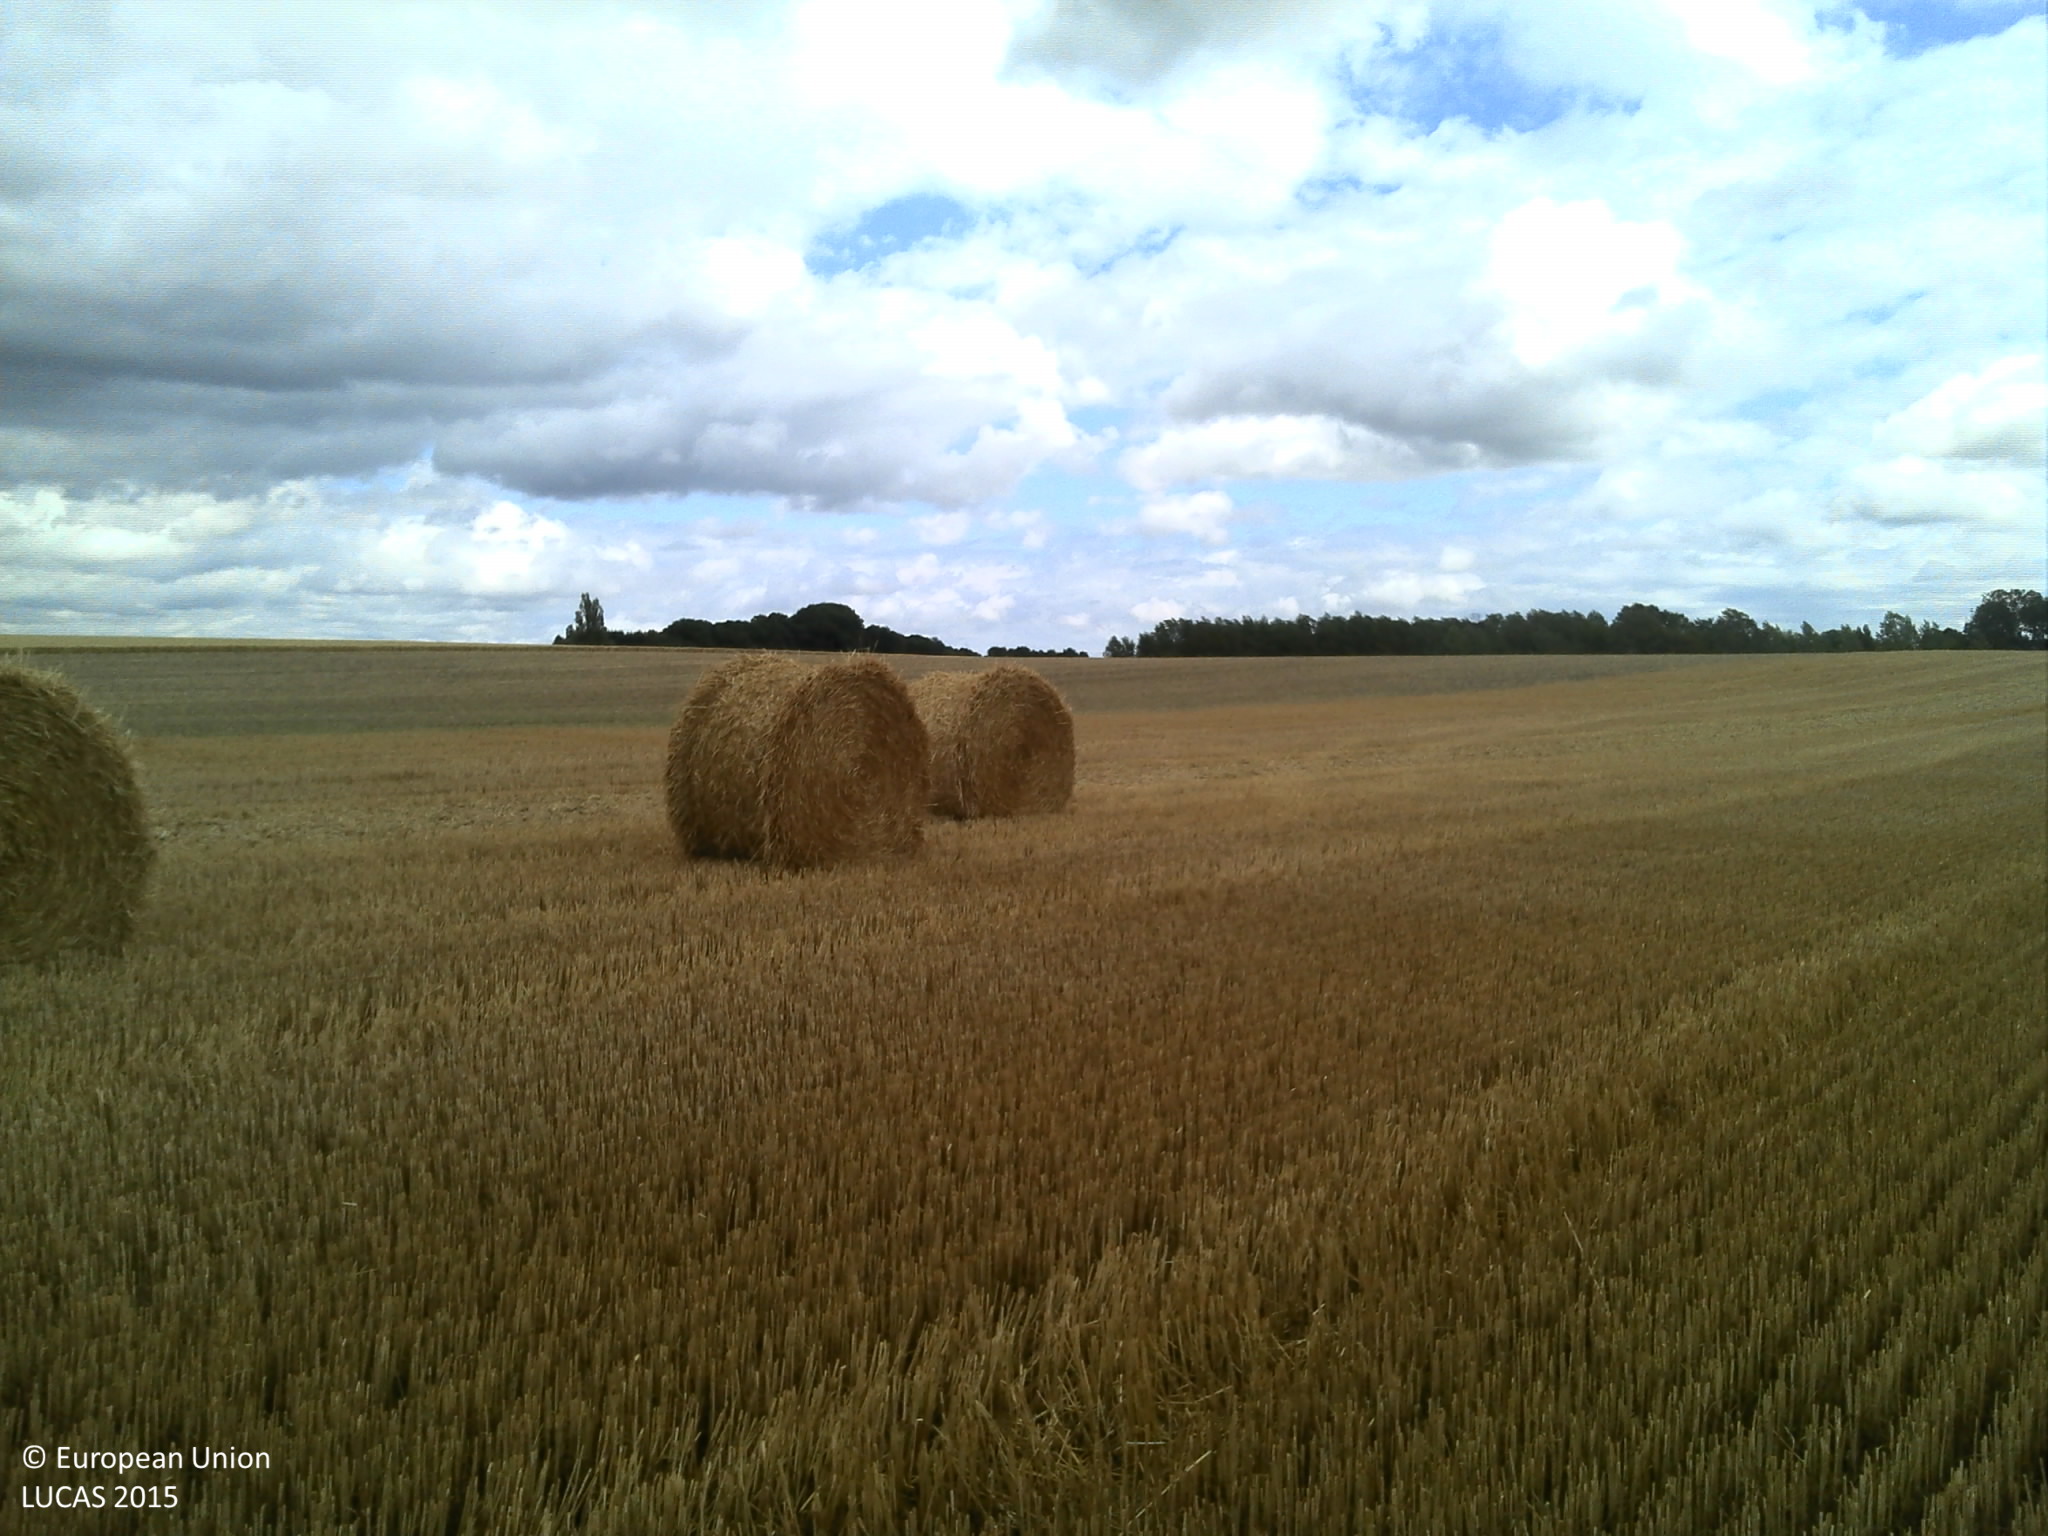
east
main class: Cropland
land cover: Common wheat
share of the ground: 50 - 75 %
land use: Agriculture (excluding fallow land and kitchen gardens)
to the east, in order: Common wheat; Other bare soil; Barley
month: July
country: FR
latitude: 49.4809
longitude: 4.6274
